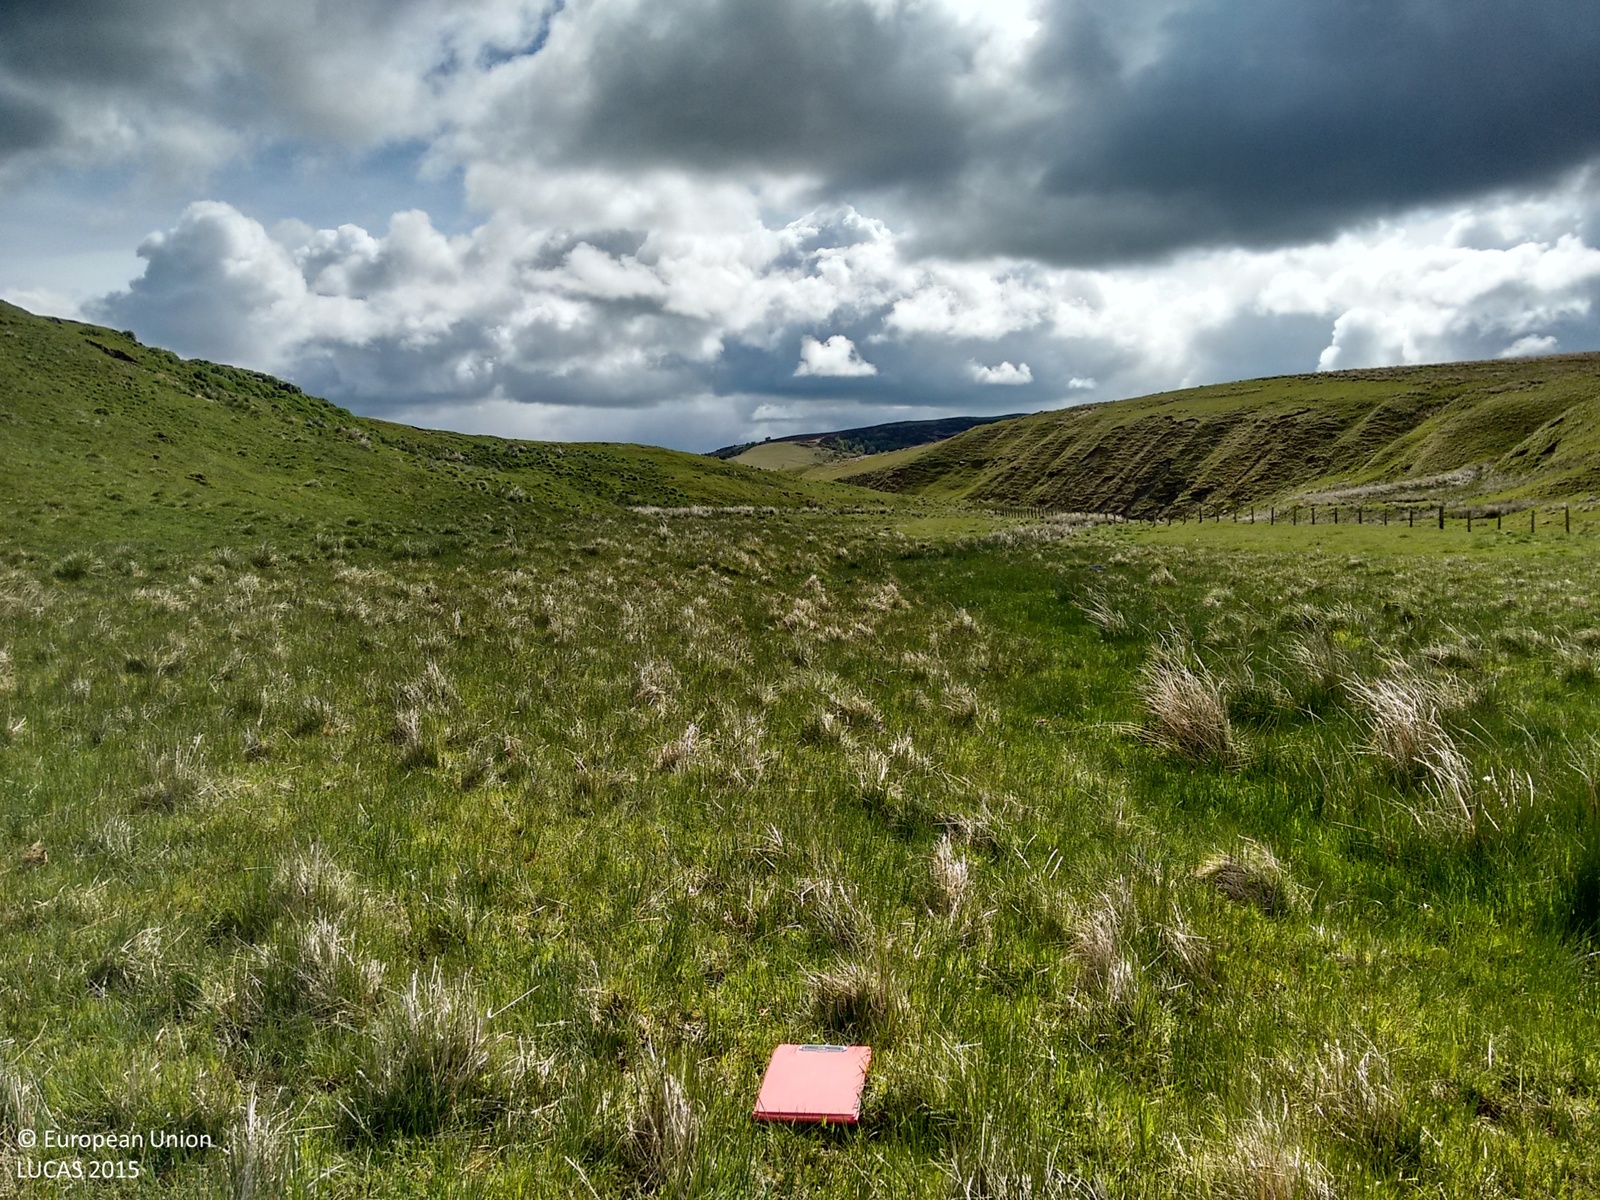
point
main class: Grassland
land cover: Grassland without tree/shrub cover
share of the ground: > 75 %
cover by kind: herbaceous plants 100 %
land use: Agriculture (excluding fallow land and kitchen gardens)
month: May
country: GB
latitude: 55.3497
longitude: -2.1840
